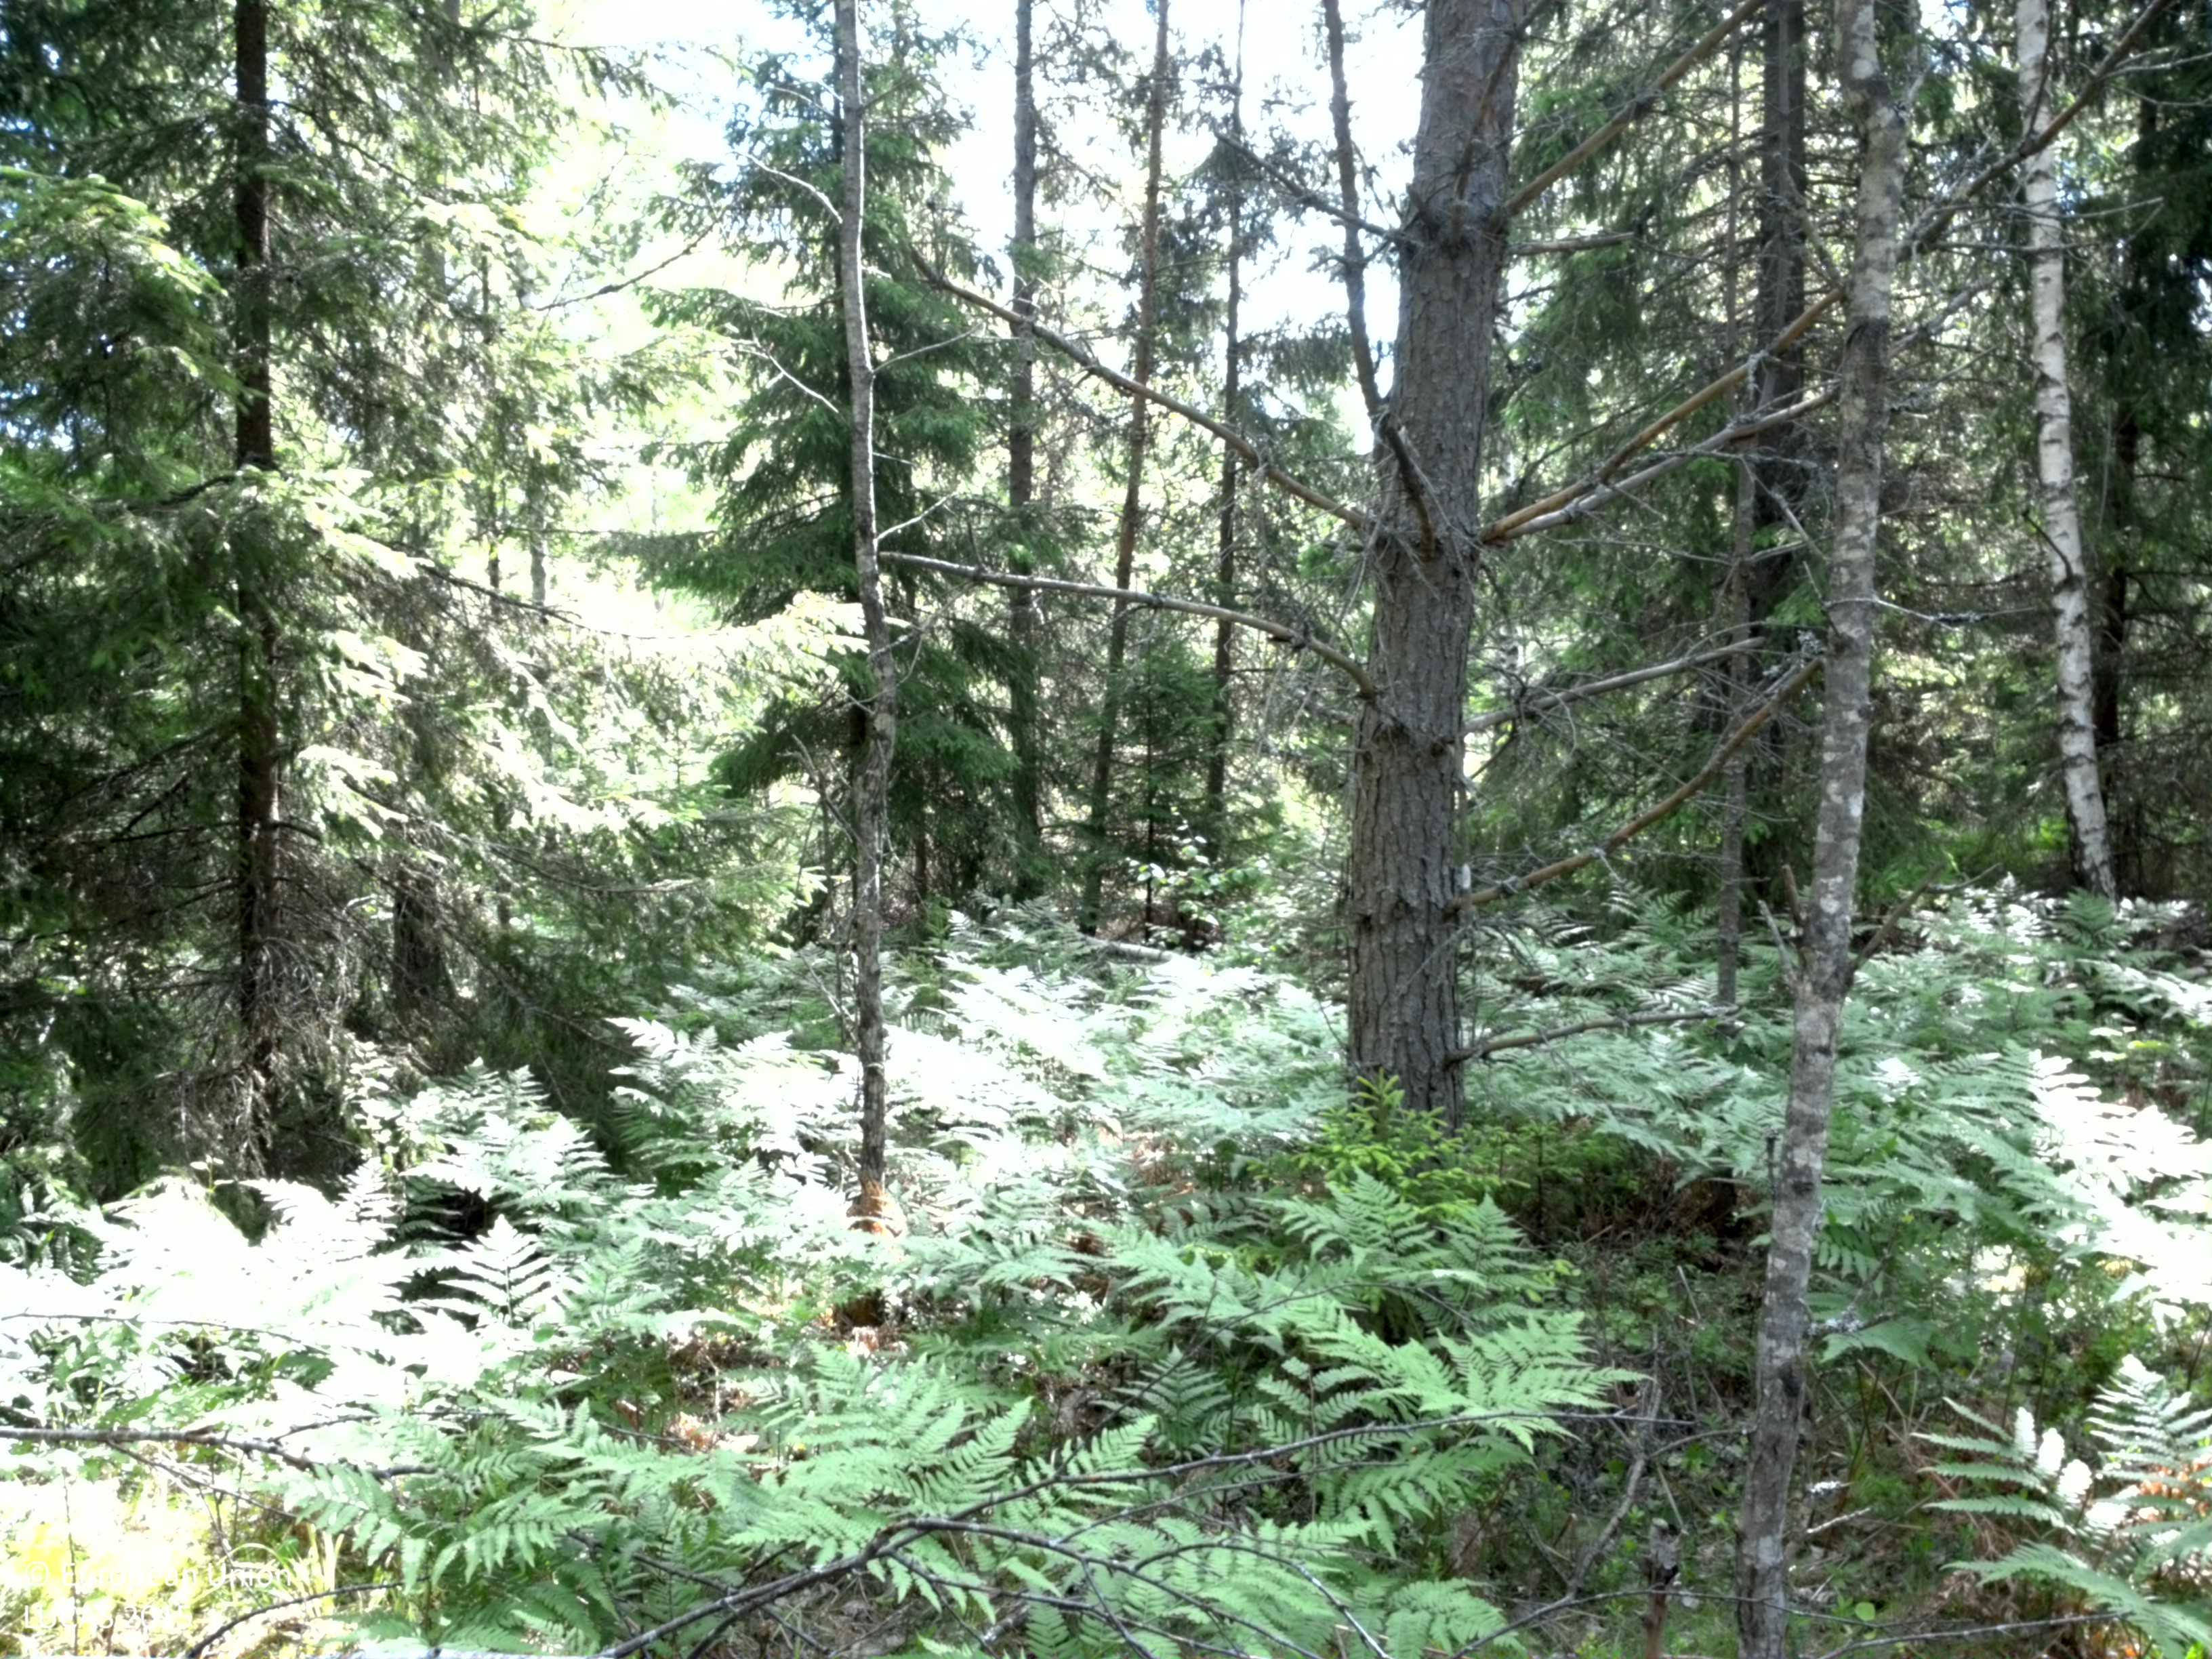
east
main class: Woodland
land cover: Spruce dominated mixed woodland
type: boreal forest
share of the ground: 50 - 75 %
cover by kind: coniferous forest trees 45 %, herbaceous plants 20 %, lichens and mosses 20 %, broadleaved forest trees 15 %
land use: Forestry
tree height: > 5 m
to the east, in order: Spruce dominated mixed woodland; Ditches and canals; Tracks; Ditches and canals; Spruce dominated mixed woodland; Pine dominated coniferous woodland; Spruce dominated coniferous woodland
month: June
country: SE
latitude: 59.6272
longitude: 18.3144
